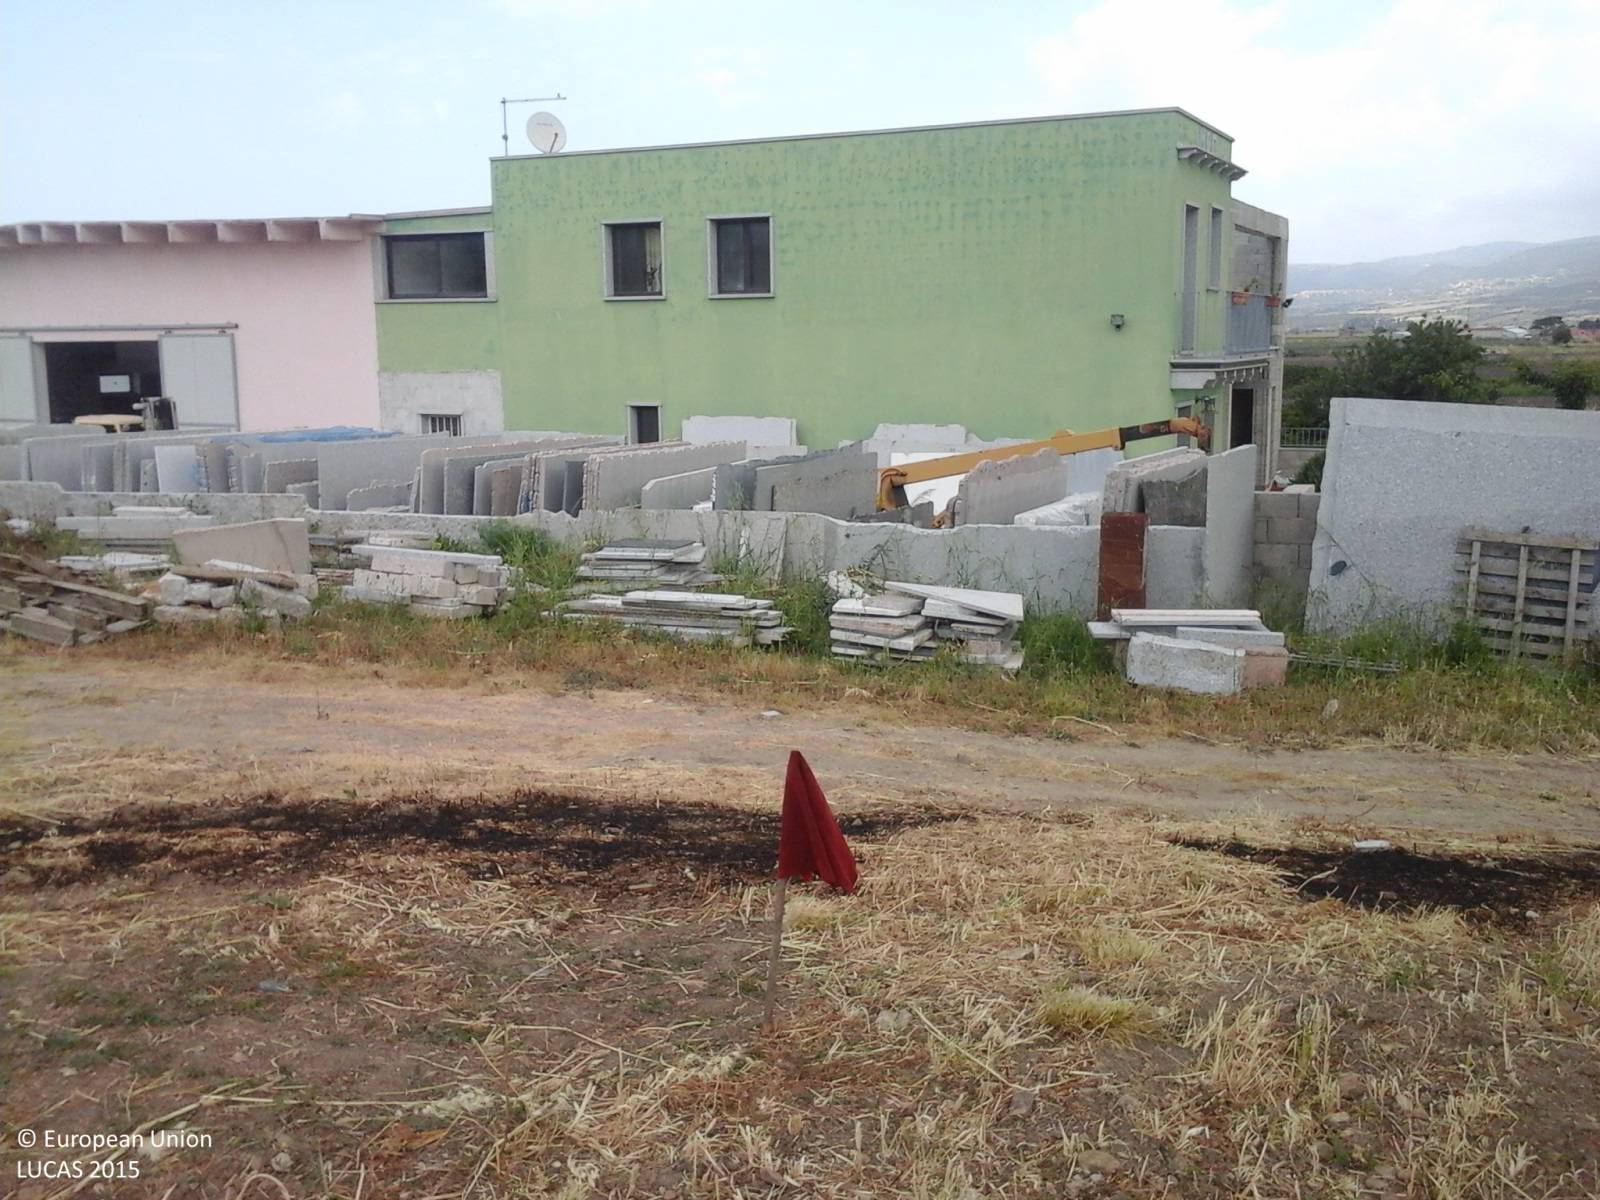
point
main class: Grassland
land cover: Grassland without tree/shrub cover
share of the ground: > 75 %
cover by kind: herbaceous plants 95 %, shrubs 5 %
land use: Semi-natural and natural areas not in use
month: May
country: IT
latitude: 40.9122
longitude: 8.8537
